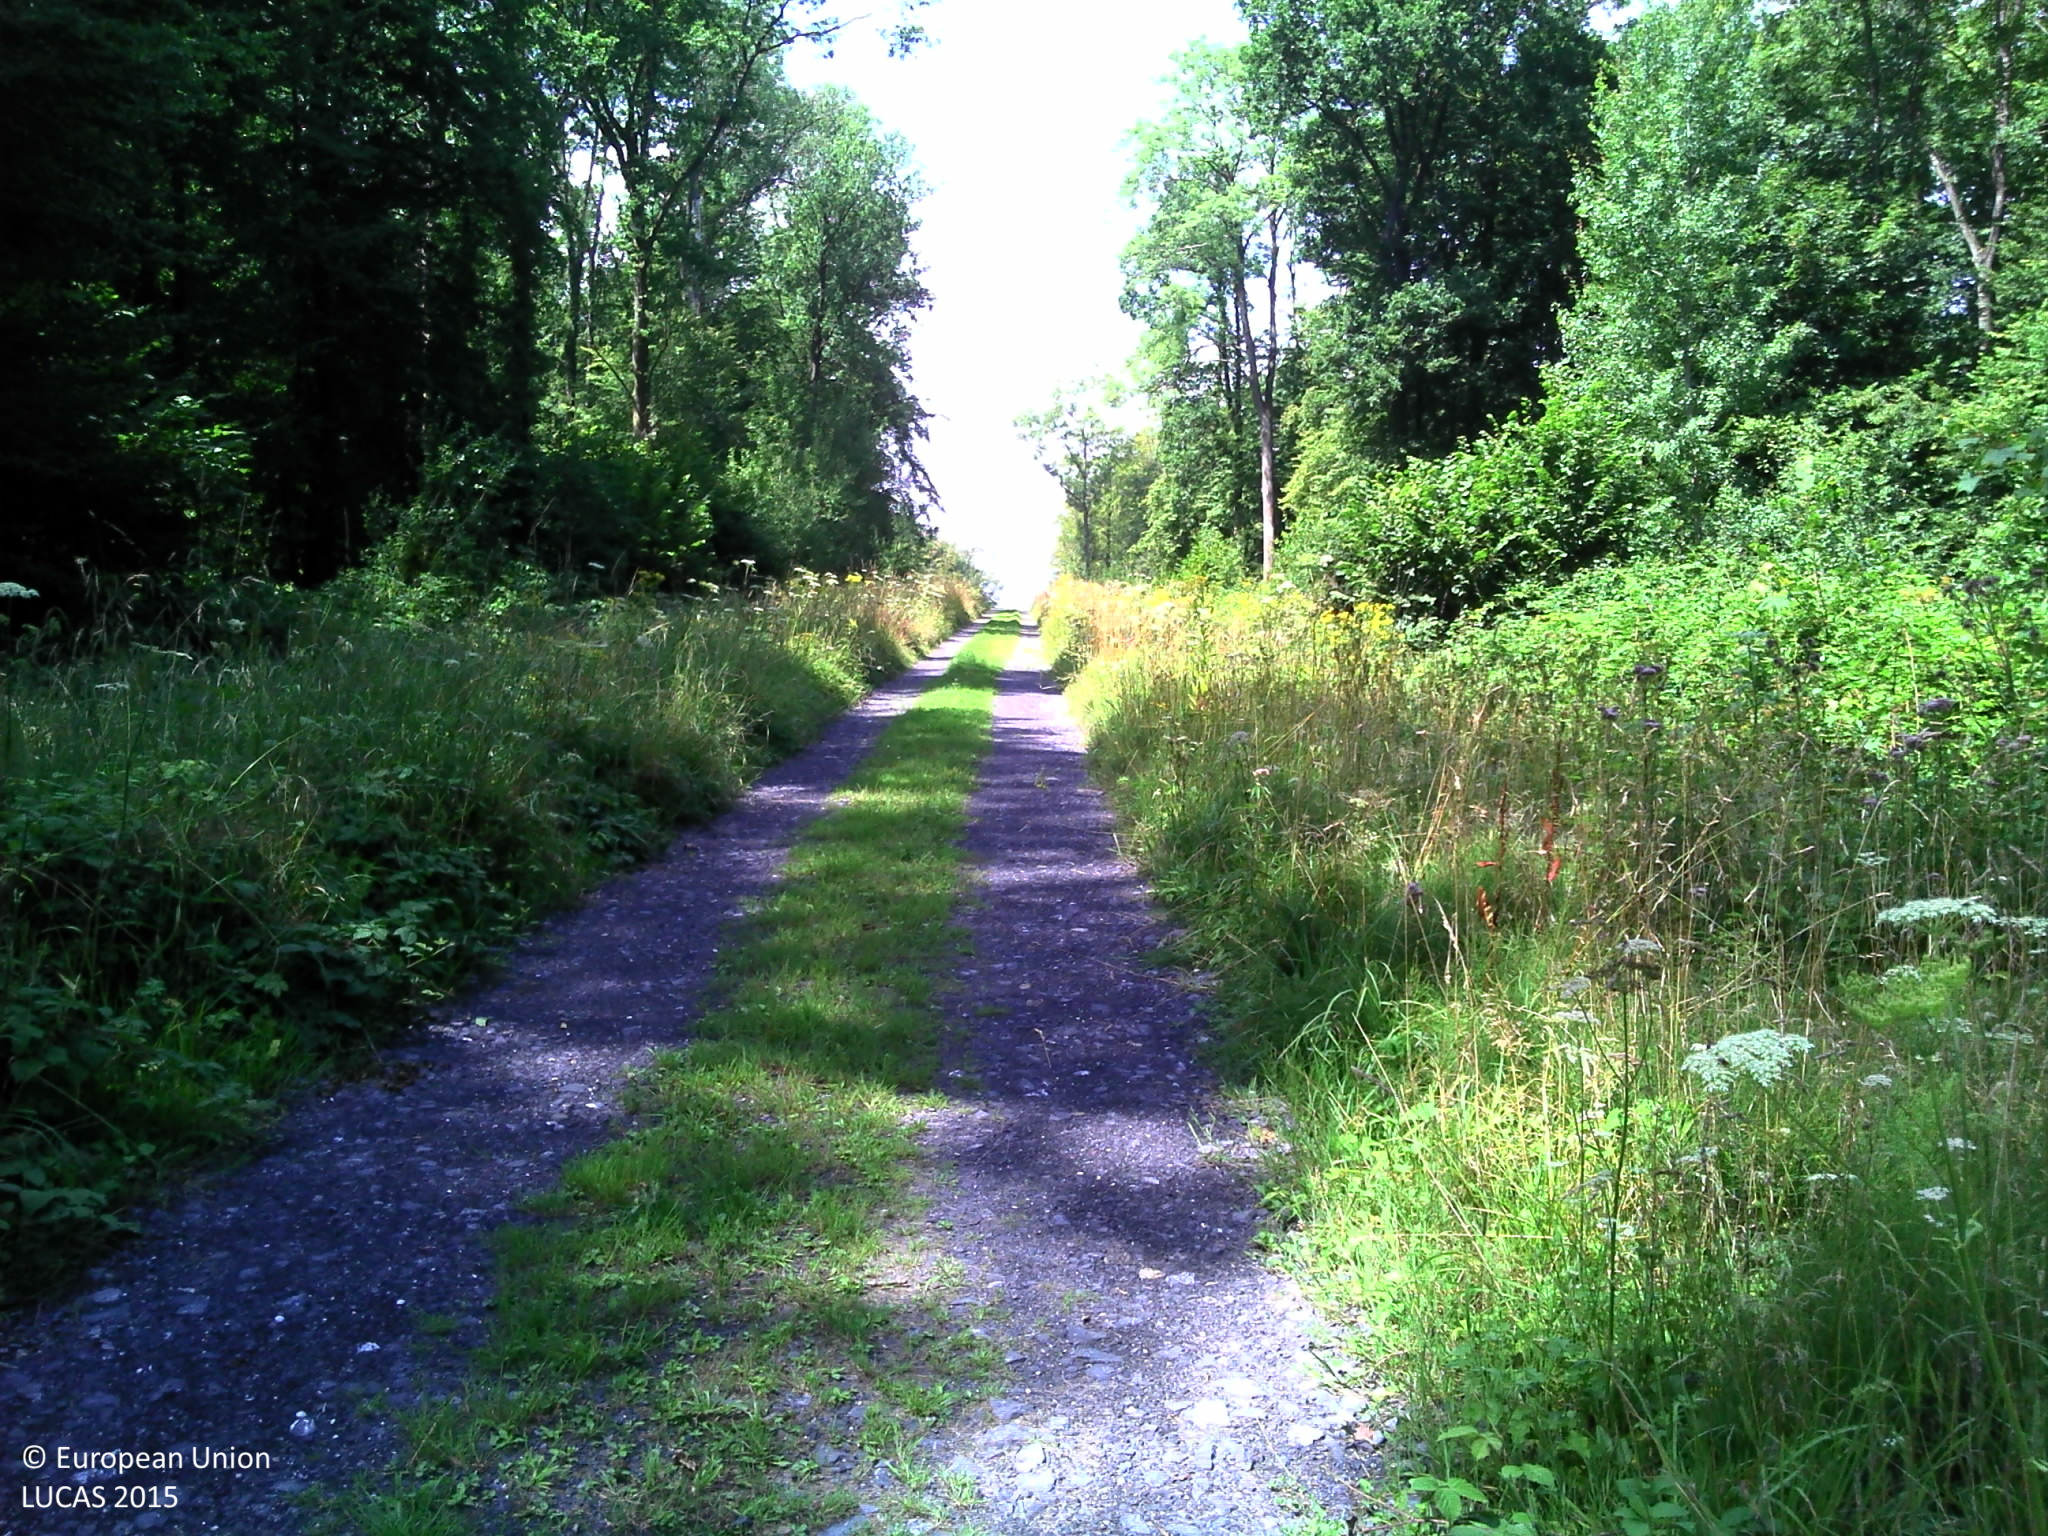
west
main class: Woodland
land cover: Broadleaved woodland
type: mesophytic deciduous forest
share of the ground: > 75 %
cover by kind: broadleaved forest trees 85 %, herbaceous plants 10 %, lichens and mosses 5 %
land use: Forestry
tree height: > 5 m
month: August
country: FR
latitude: 49.9922
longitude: 4.0384
